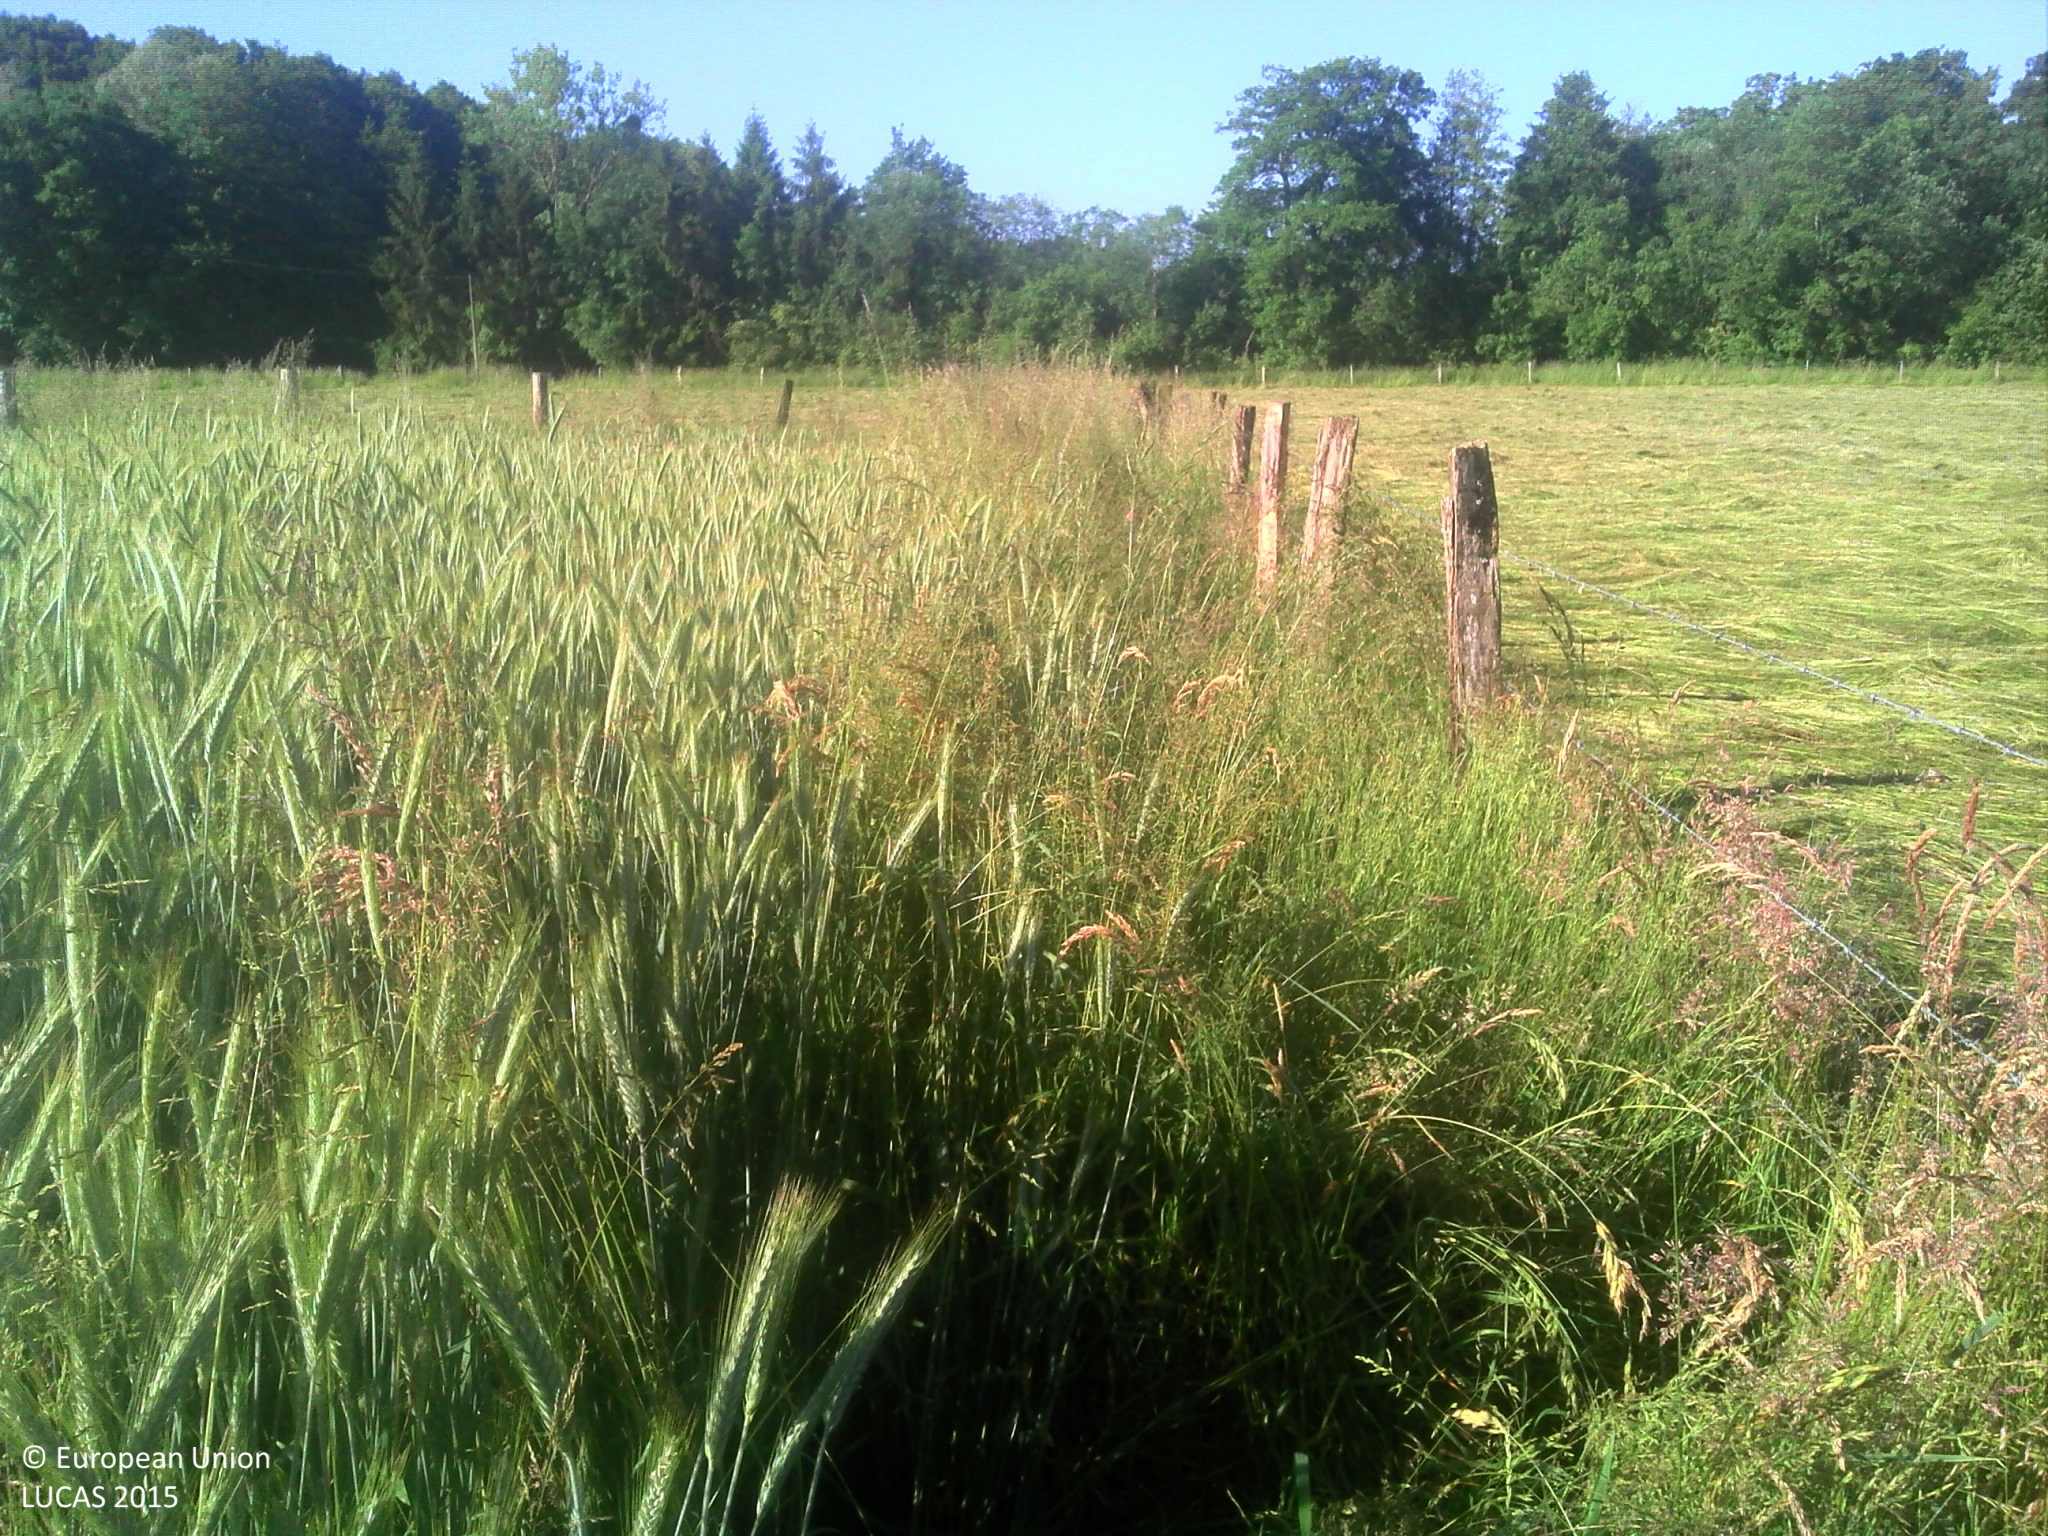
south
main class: Cropland
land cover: Triticale
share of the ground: > 75 %
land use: Agriculture (excluding fallow land and kitchen gardens)
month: June
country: FR
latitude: 48.5098
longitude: 4.6779
